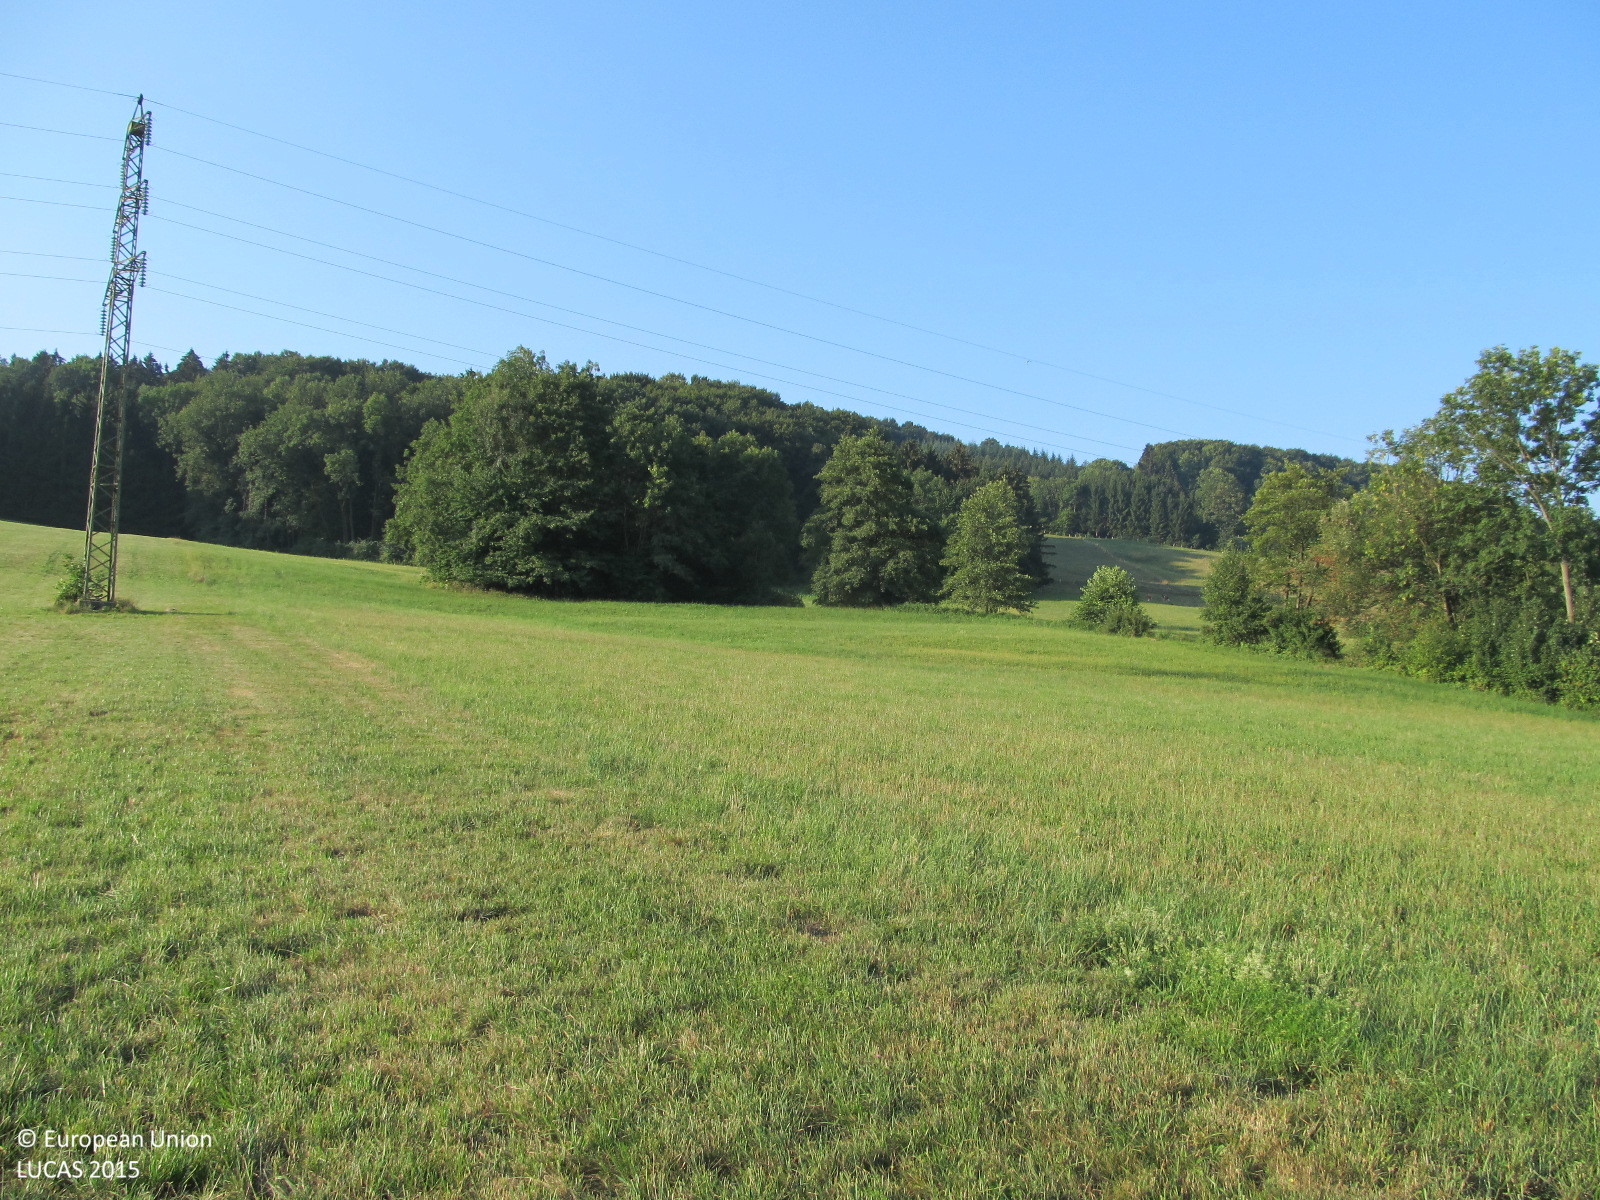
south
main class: Grassland
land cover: Grassland without tree/shrub cover
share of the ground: > 75 %
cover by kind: herbaceous plants 100 %
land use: Agriculture (excluding fallow land and kitchen gardens)
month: August
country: AT
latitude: 48.1072
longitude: 15.4413
